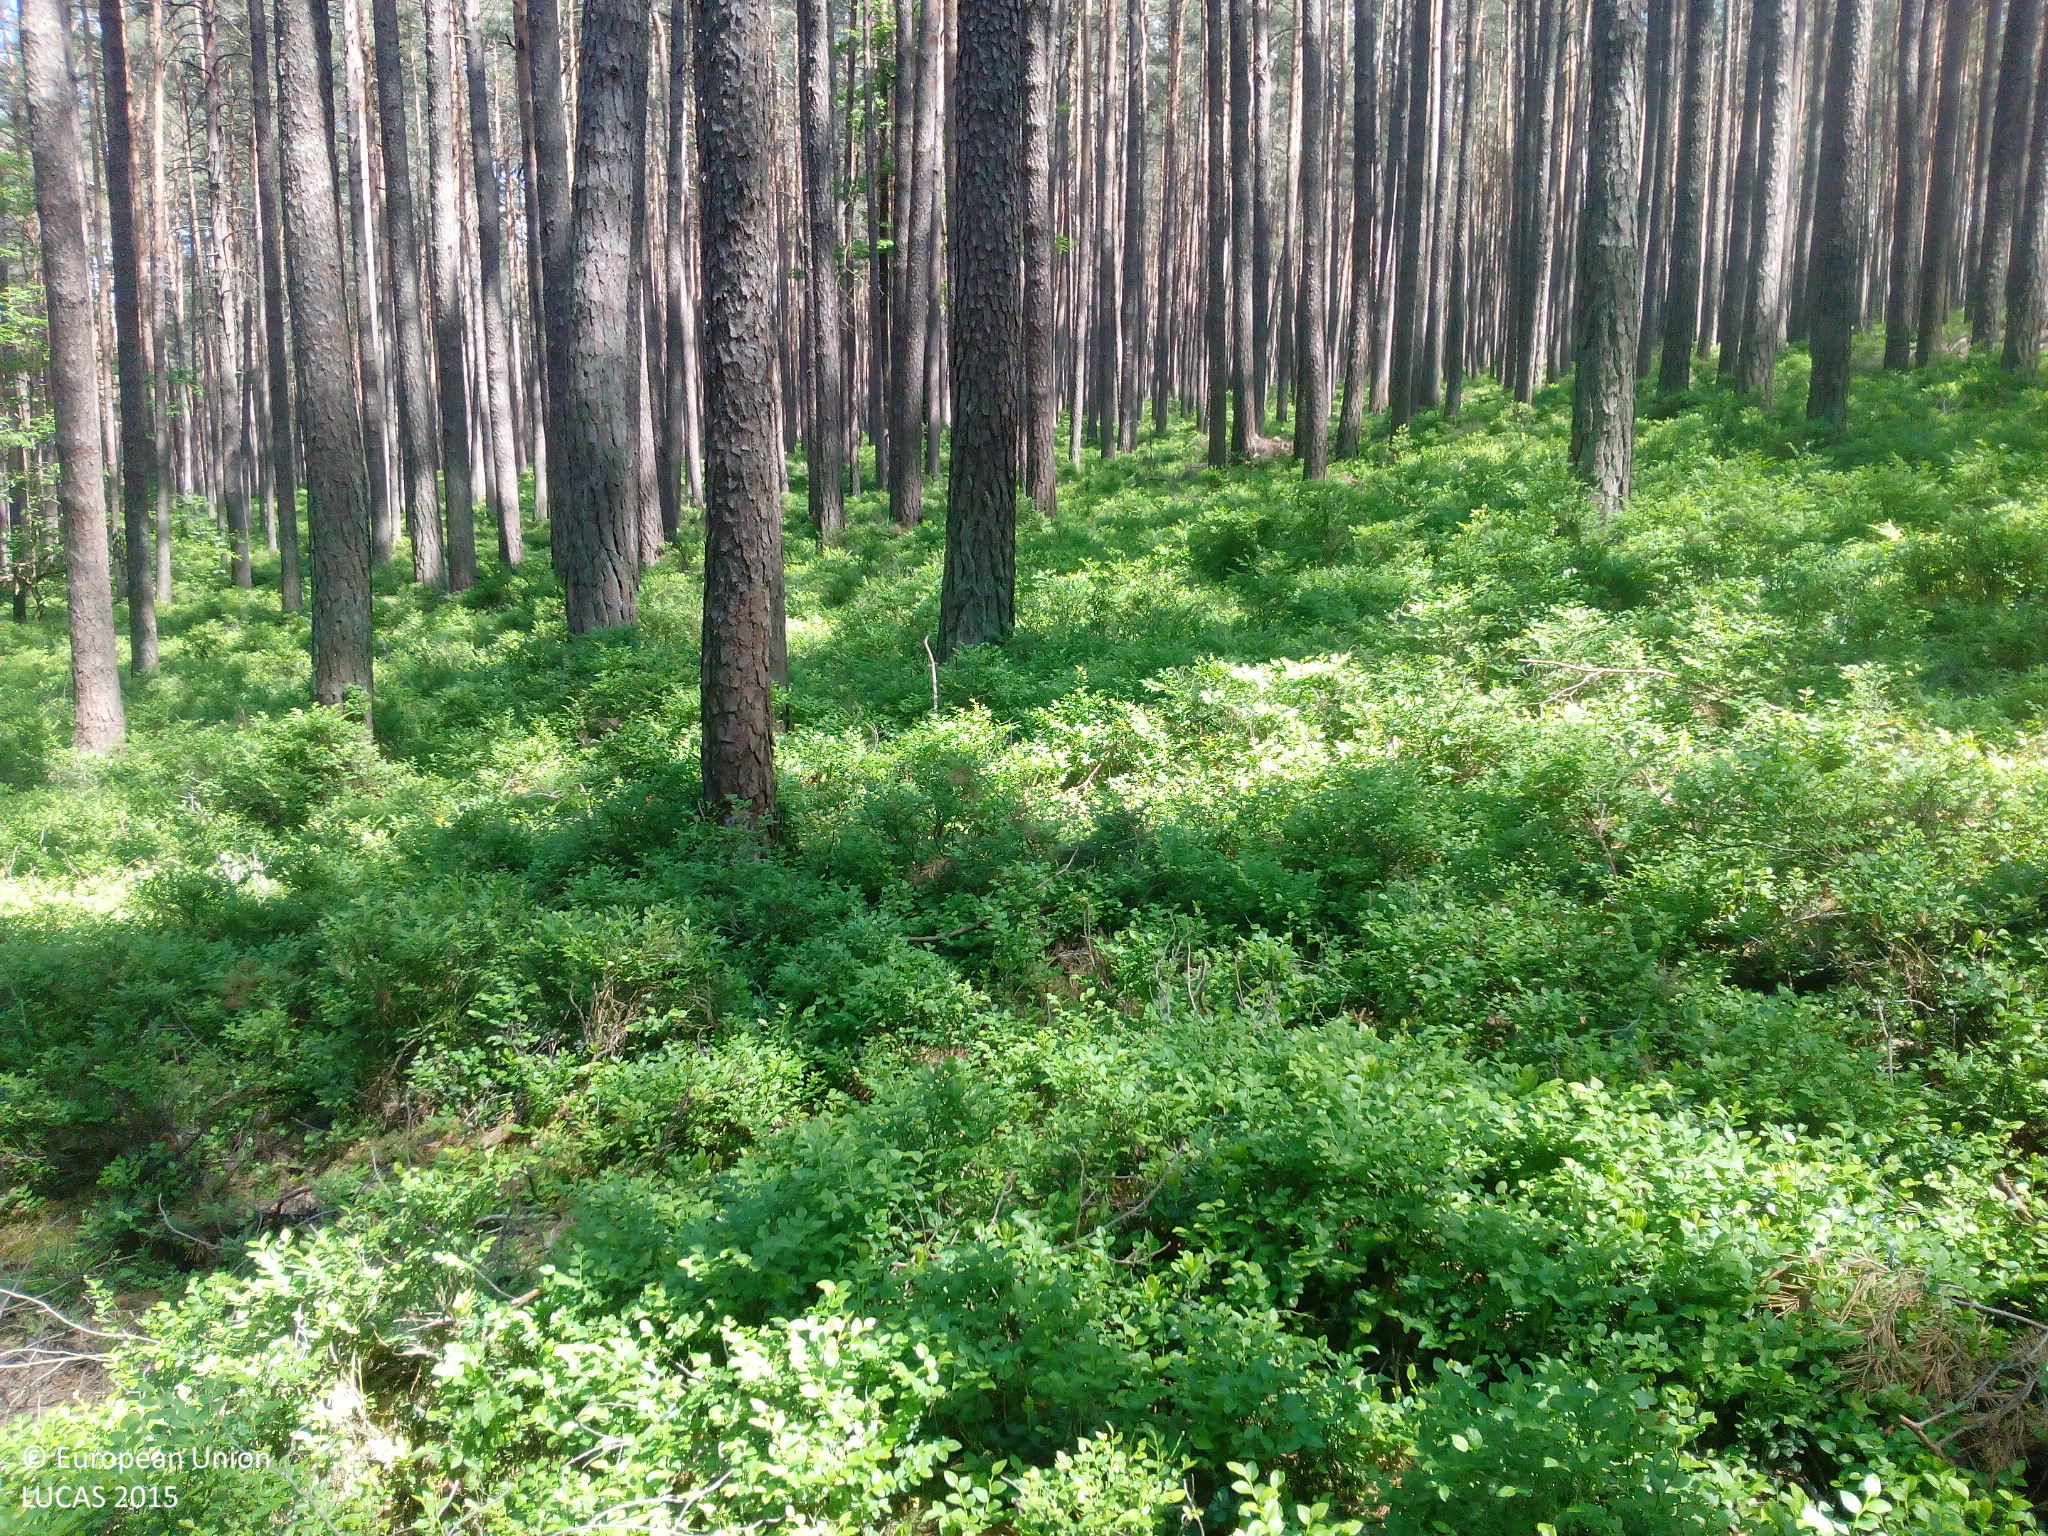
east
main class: Woodland
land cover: Pine dominated coniferous woodland
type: hemiboreal forest and nemoral coniferous forest and mixed broadleaved-coniferous forest
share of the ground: > 75 %
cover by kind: coniferous forest trees 85 %, herbaceous plants 15 %
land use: Forestry
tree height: > 5 m
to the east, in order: Pine dominated coniferous woodland; Ditches and canals; Pine dominated coniferous woodland; Tracks; Pine dominated coniferous woodland; Tracks; Pine dominated coniferous woodland
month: May
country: DE
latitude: 49.1915
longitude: 10.8916
